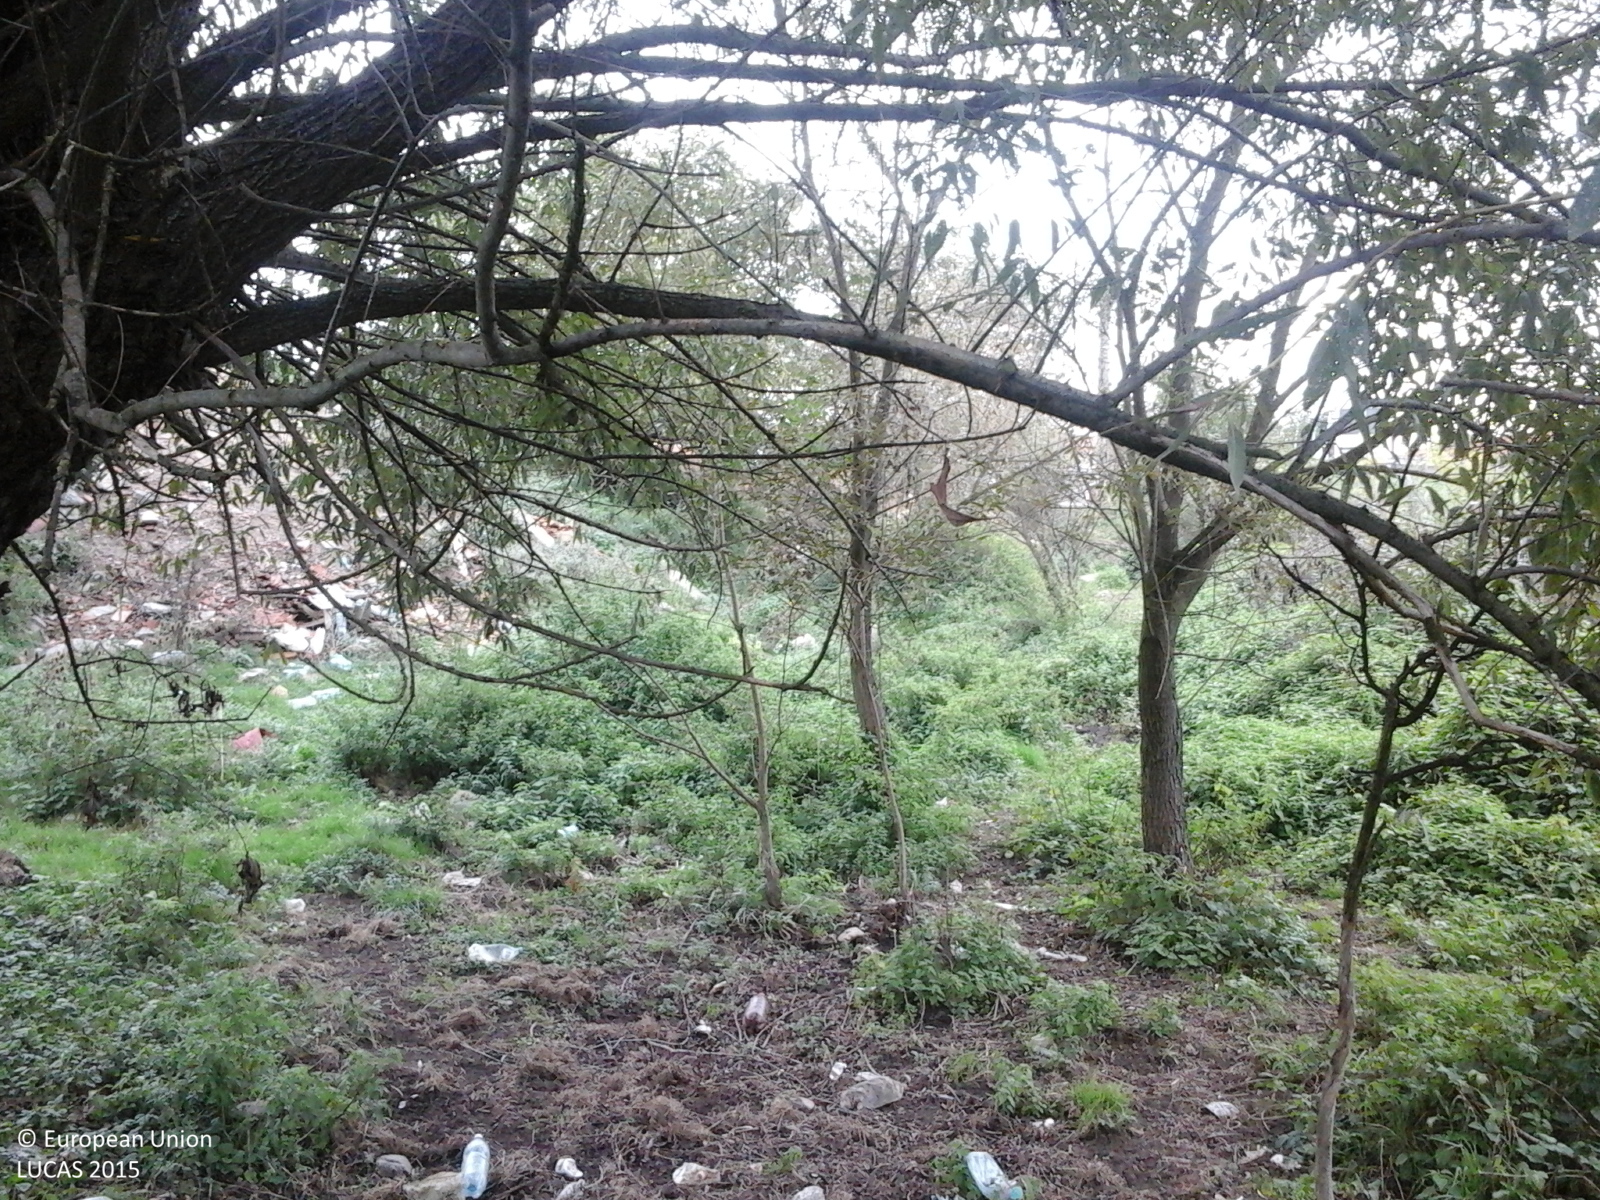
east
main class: Grassland
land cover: Grassland with sparse tree/shrub cover
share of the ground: > 75 %
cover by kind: herbaceous plants 90 %, broadleaved forest trees 5 %, shrubs 5 %
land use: Agriculture (excluding fallow land and kitchen gardens)
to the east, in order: Grassland with sparse tree/shrub cover; Artificial constructions in urban areas; Other fruit trees and berries; Fences; Other fruit trees and berries; Fences; Grass margins; Tracks; Grass margins; Grassland without tree/shrub cover; Other leguminous and mixtures for fodder
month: September
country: RO
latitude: 45.8081
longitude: 23.3010
